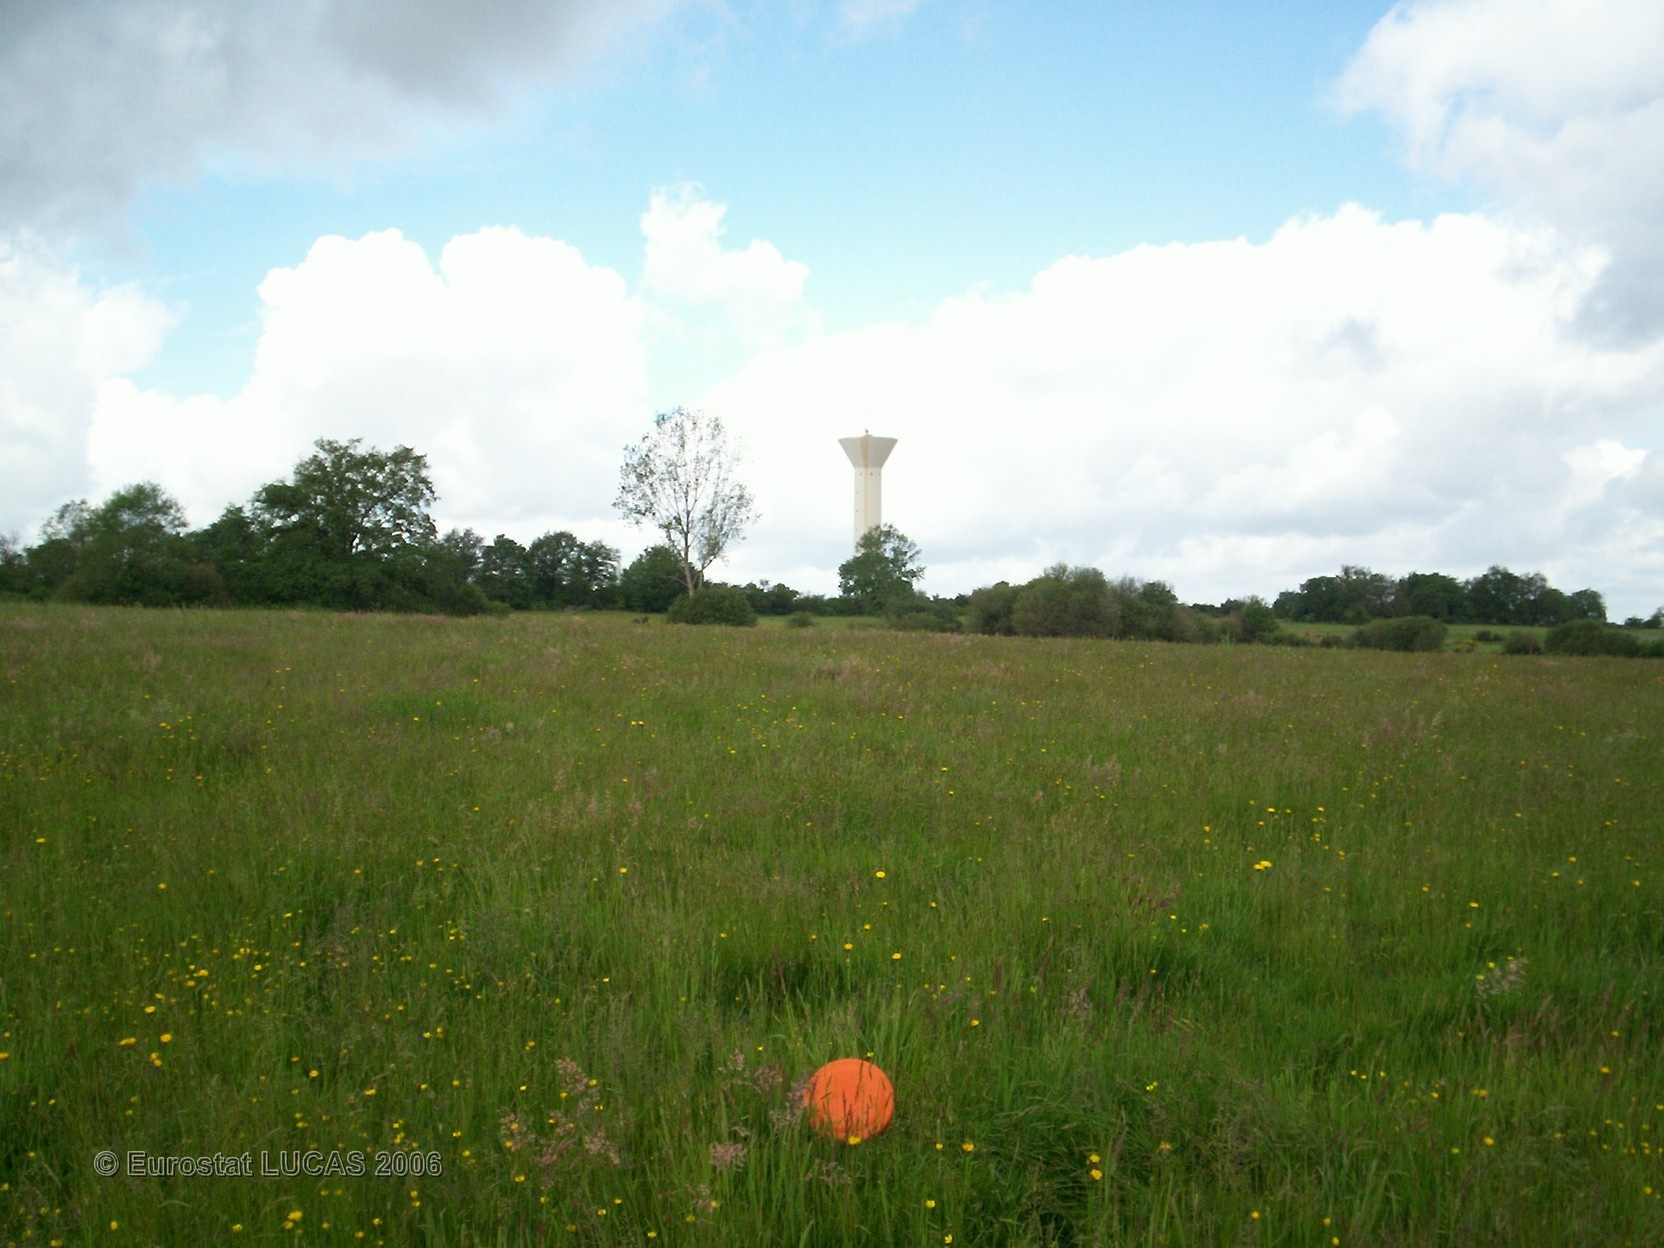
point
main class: Grassland
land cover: Grassland without tree/shrub cover
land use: Agriculture (excluding fallow land and kitchen gardens)
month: May
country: FR
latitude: 46.0356
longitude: 0.6961
